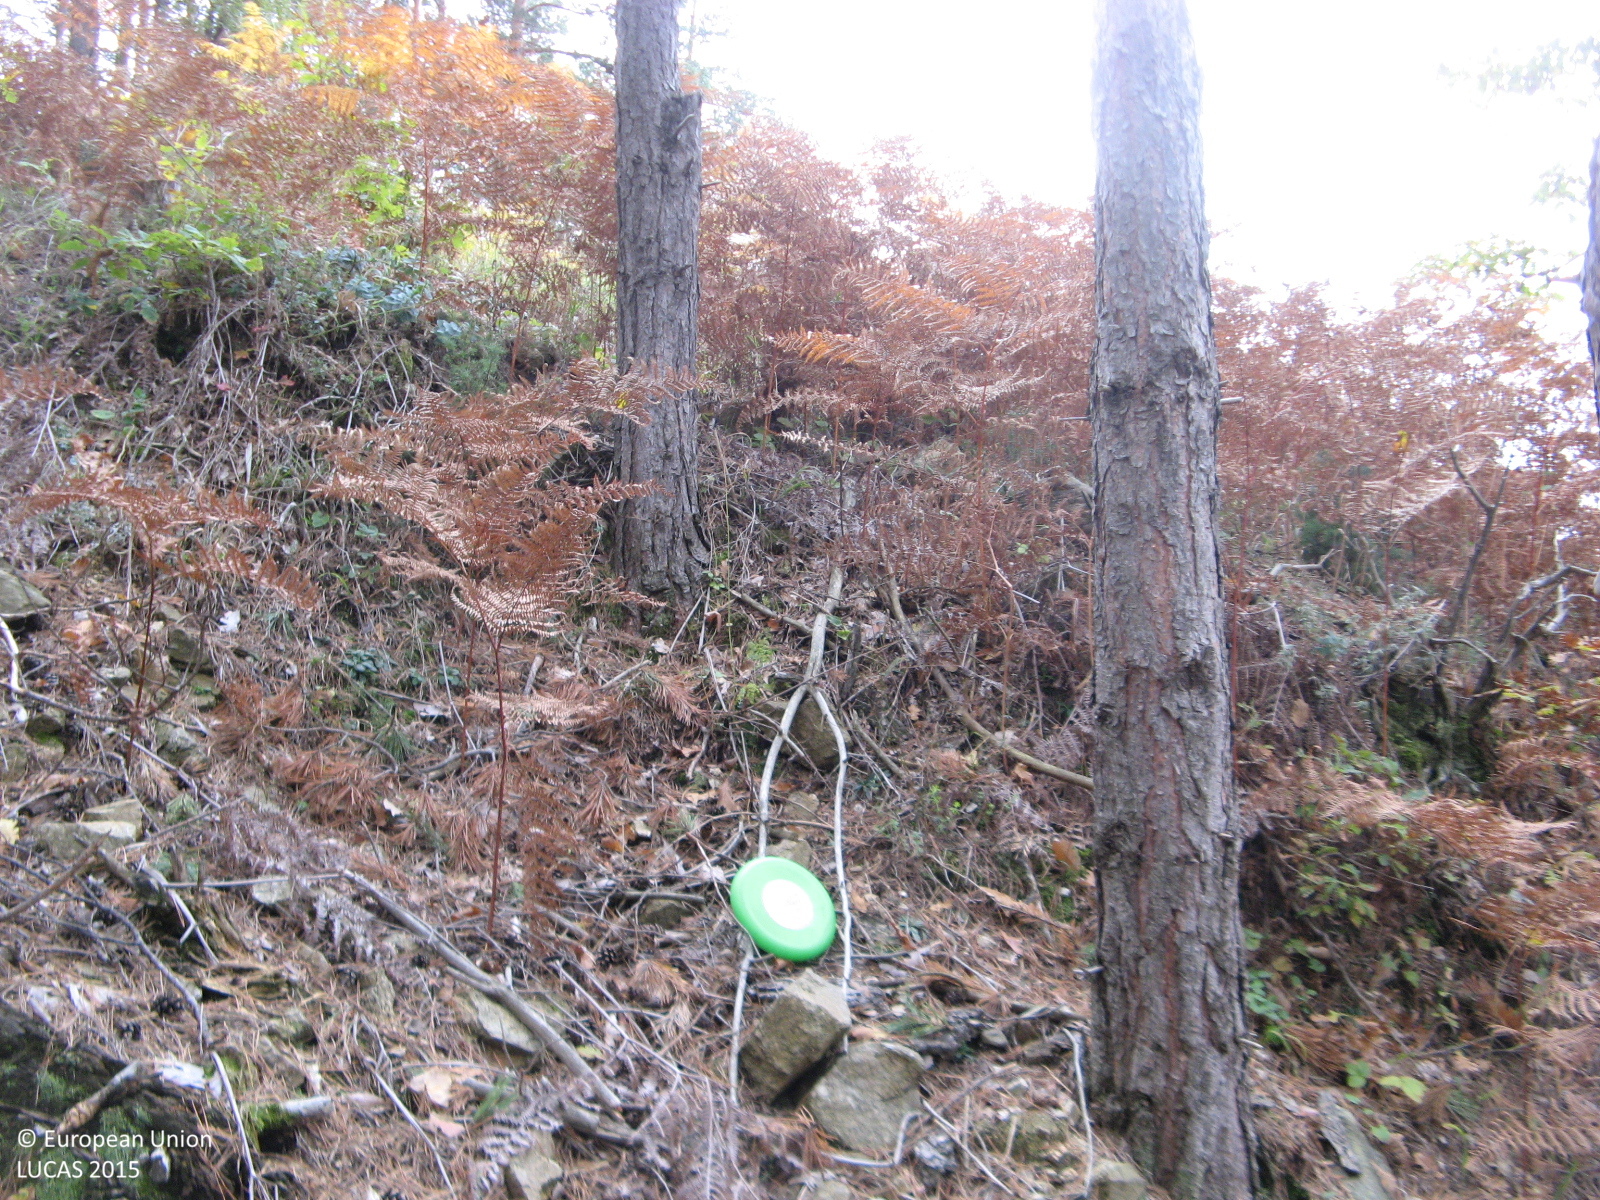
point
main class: Woodland
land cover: Pine dominated coniferous woodland
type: hemiboreal forest and nemoral coniferous forest and mixed broadleaved-coniferous forest
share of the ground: > 75 %
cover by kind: coniferous forest trees 75 %, broadleaved forest trees 25 %
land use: Forestry
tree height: > 5 m
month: October
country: BG
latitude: 41.4312
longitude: 25.1643
